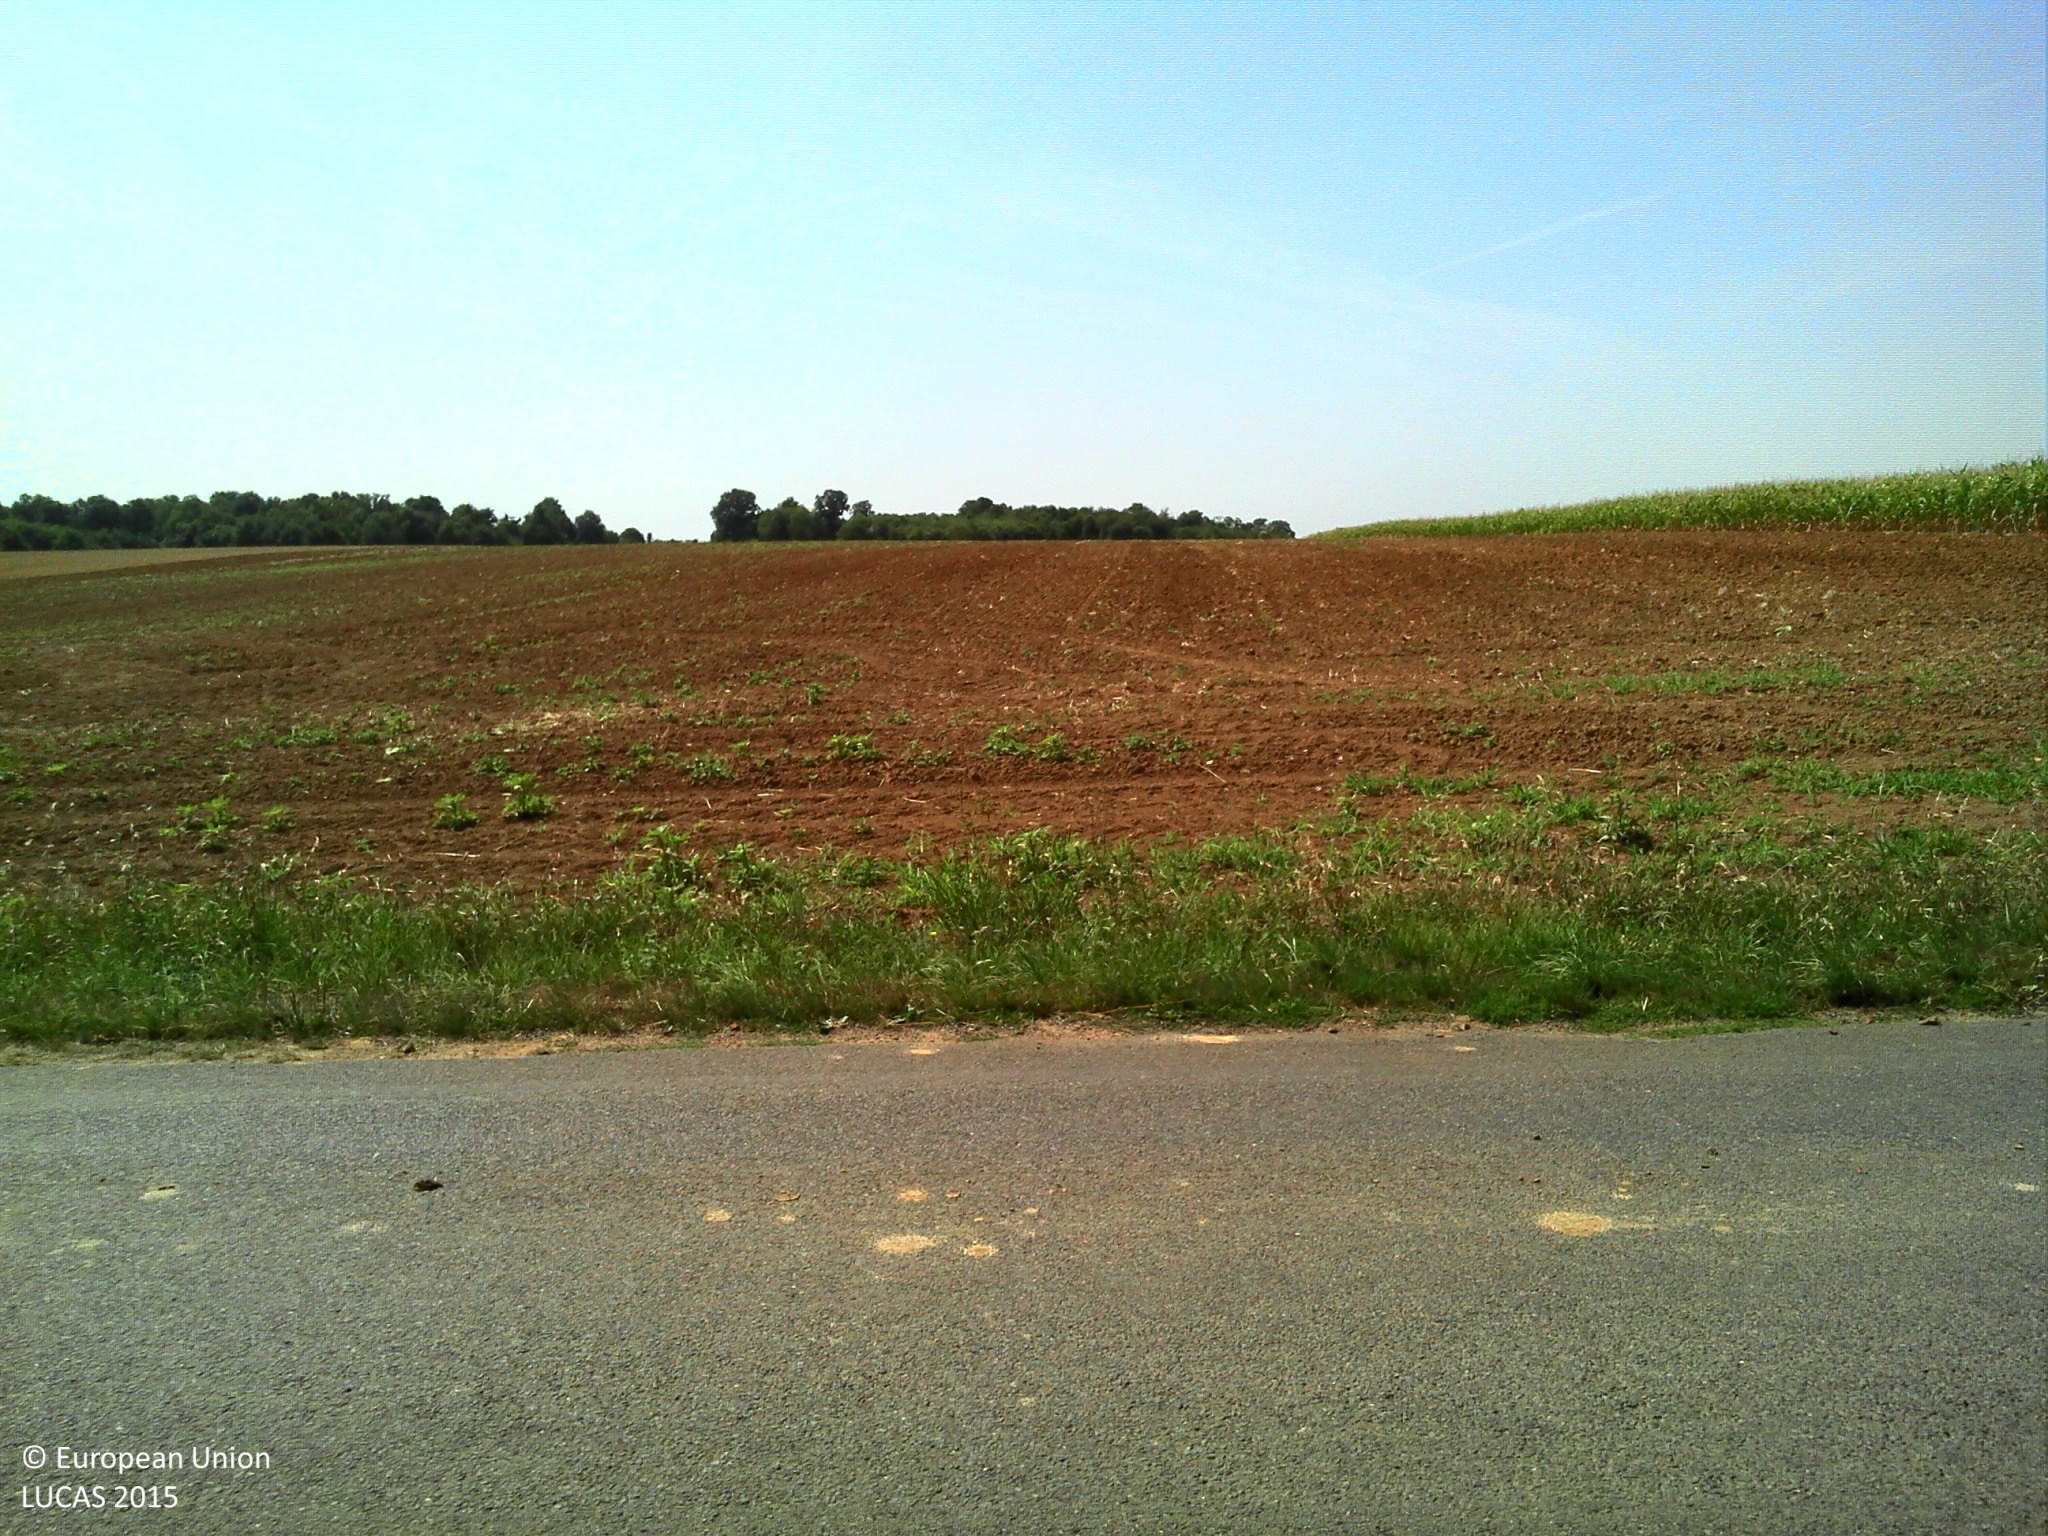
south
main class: Cropland
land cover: Maize
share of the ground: > 75 %
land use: Agriculture (excluding fallow land and kitchen gardens)
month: August
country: FR
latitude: 46.2176
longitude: 0.2985
